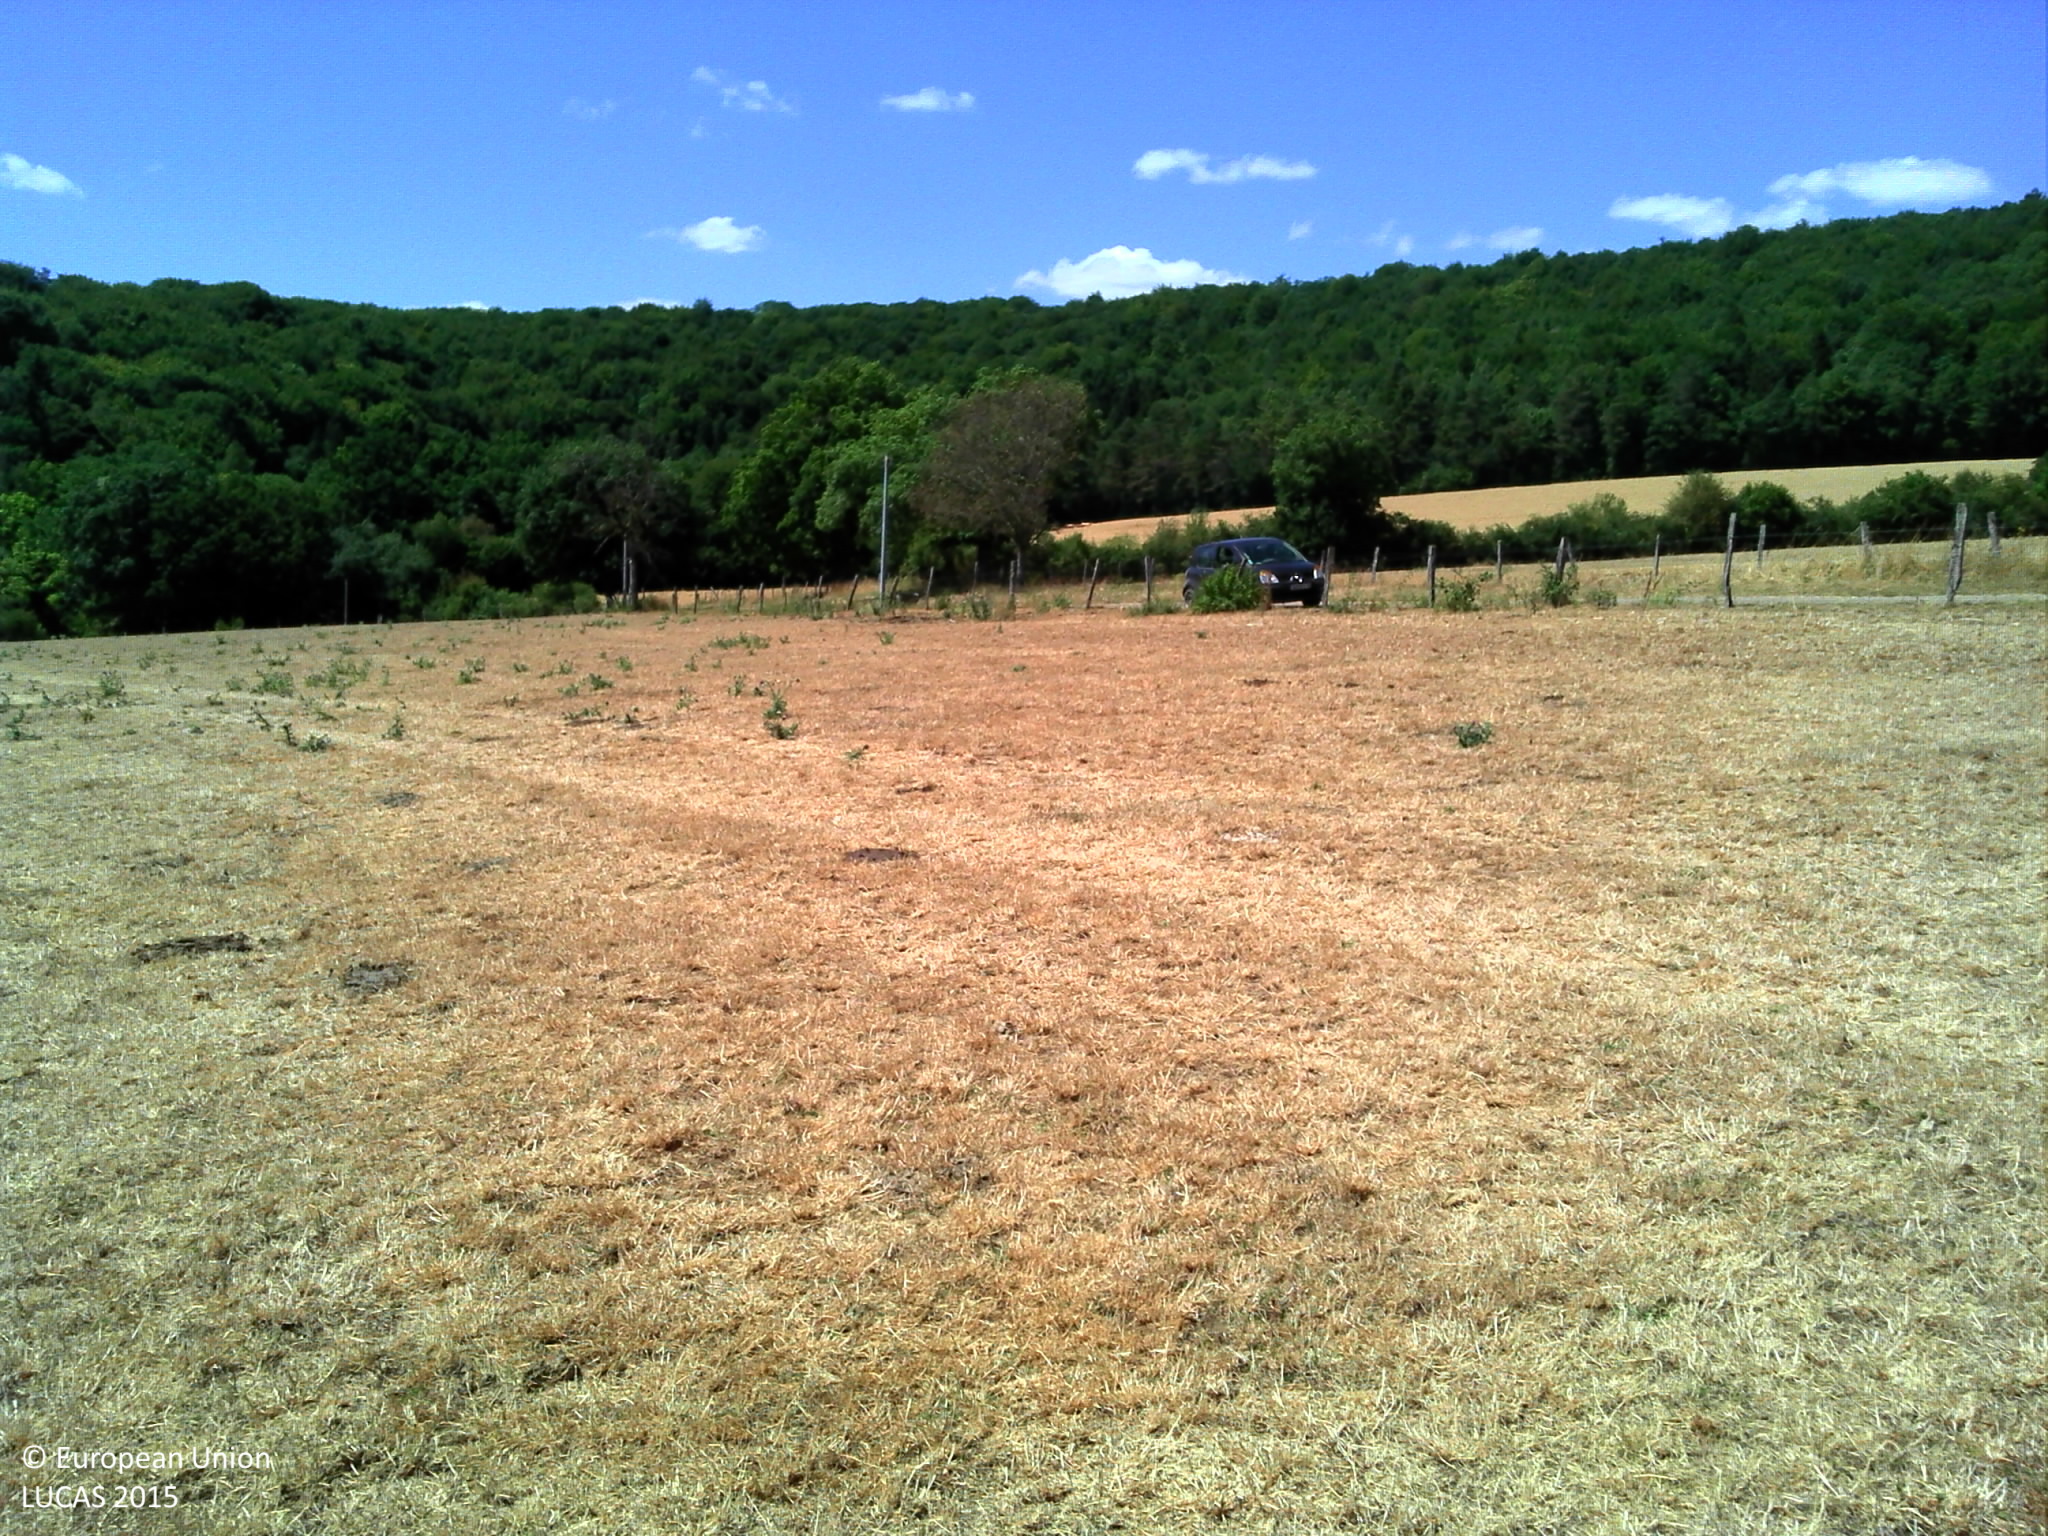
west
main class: Grassland
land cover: Grassland without tree/shrub cover
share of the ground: > 75 %
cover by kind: herbaceous plants 100 %
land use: Agriculture (excluding fallow land and kitchen gardens)
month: July
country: FR
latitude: 47.8428
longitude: 5.0689
